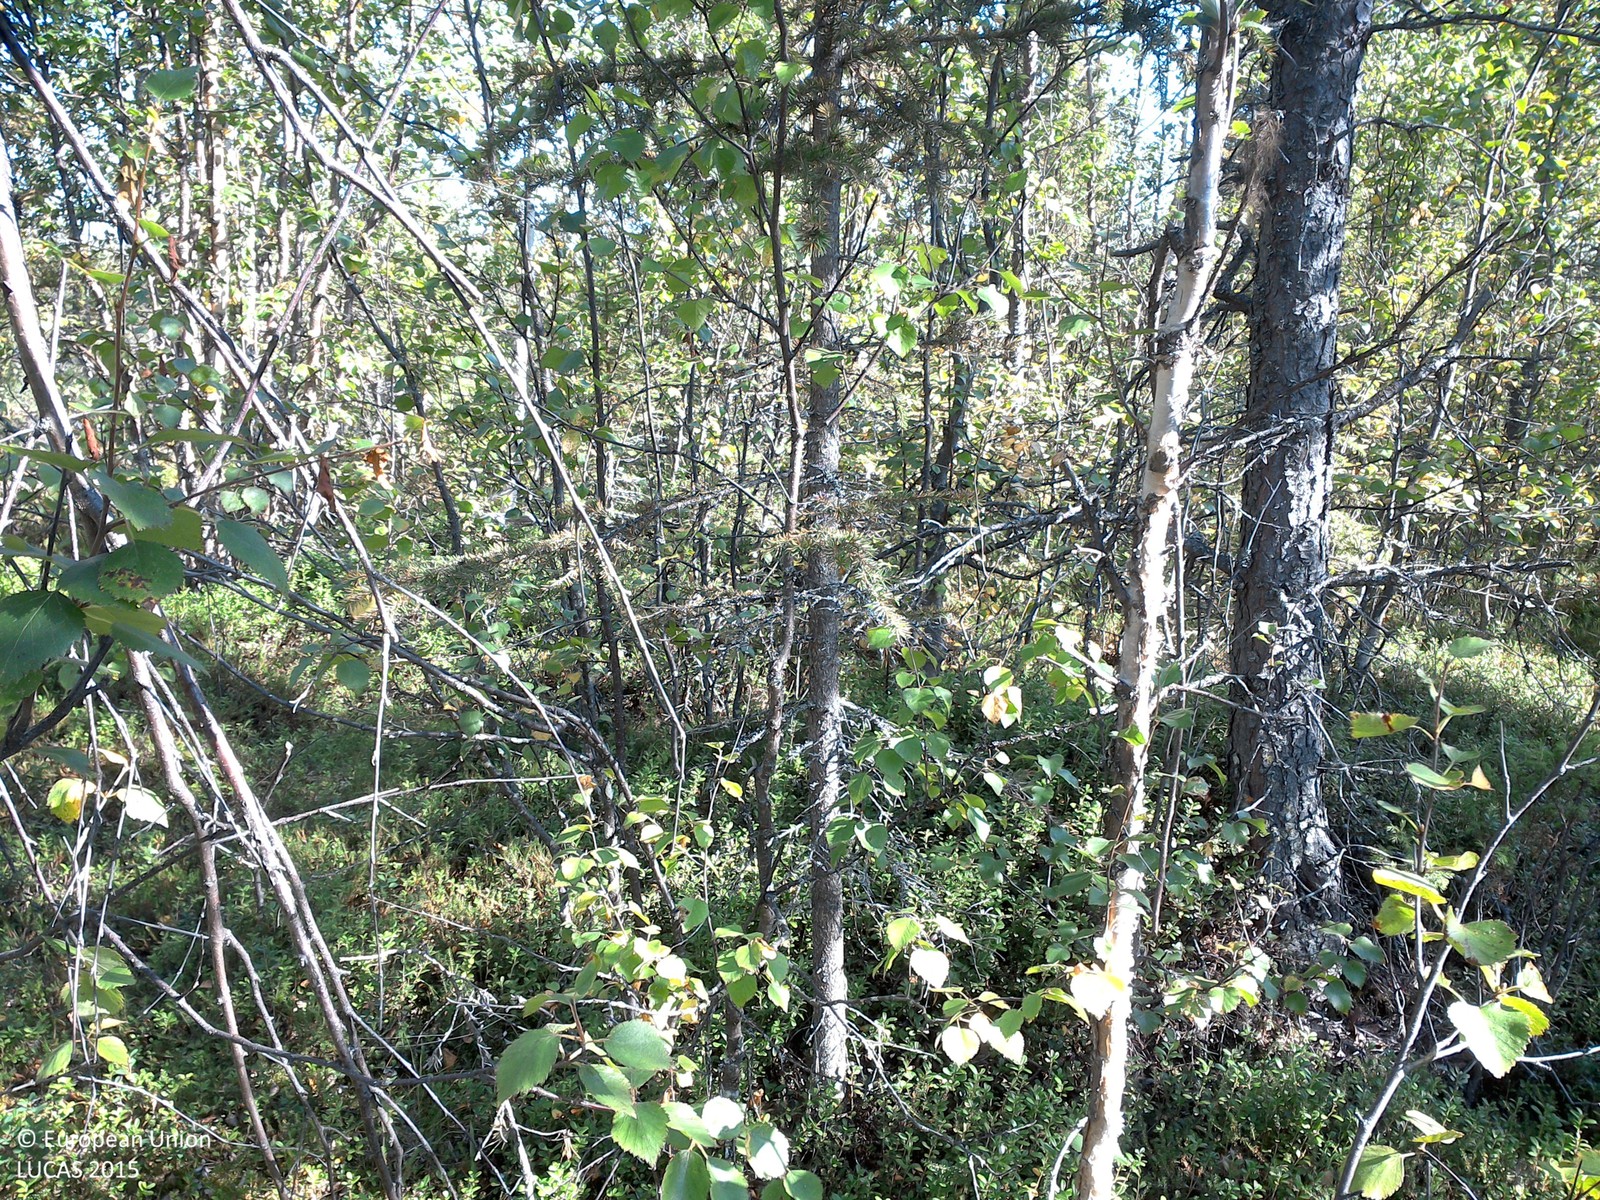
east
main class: Woodland
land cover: Other mixed woodland
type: boreal forest
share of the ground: 25 - 50 %
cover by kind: shrubs 60 %, broadleaved forest trees 25 %, coniferous forest trees 10 %, lichens and mosses 5 %
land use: Forestry
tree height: > 5 m
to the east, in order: Other mixed woodland; Shrubland with sparse tree cover; Spruce dominated mixed woodland; Pine dominated mixed woodland; Other coniferous woodland; Pine dominated mixed woodland
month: August
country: SE
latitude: 67.3828
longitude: 22.0959
